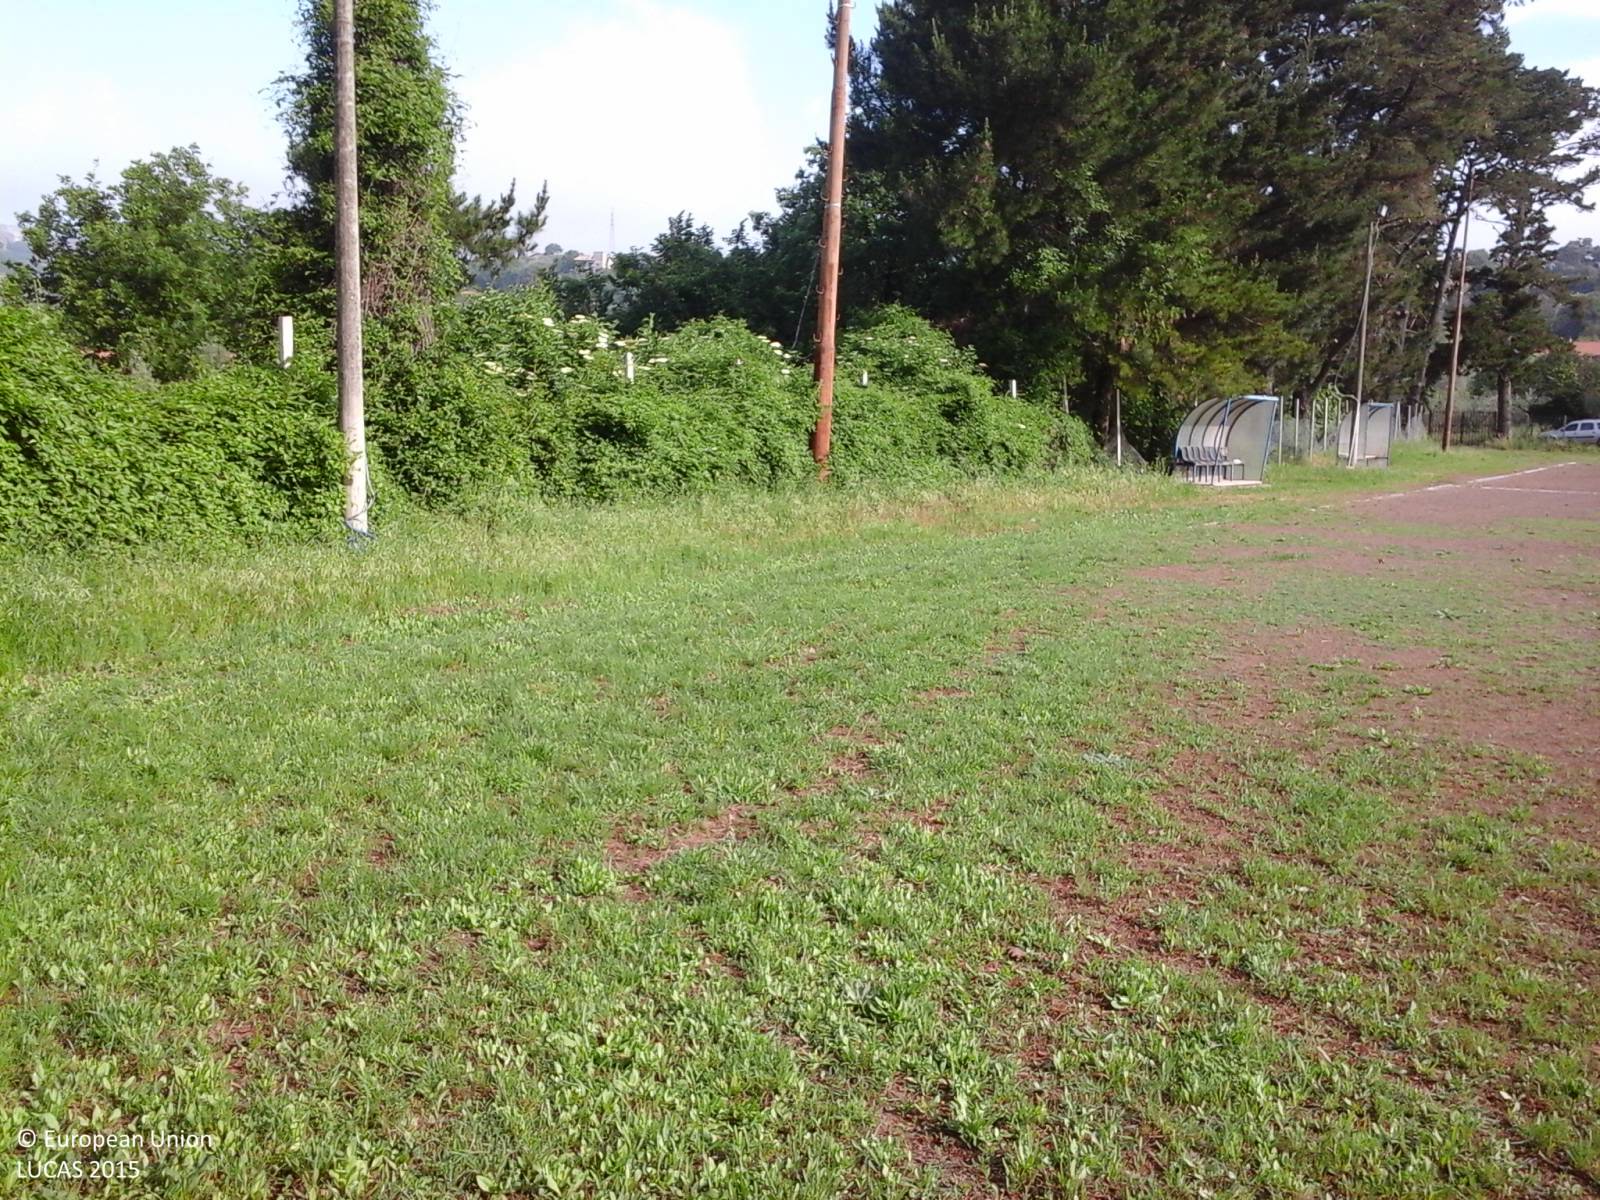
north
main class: Grassland
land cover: Grassland without tree/shrub cover
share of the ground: > 75 %
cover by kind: herbaceous plants 100 %
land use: Sport
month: May
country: IT
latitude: 42.5249
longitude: 12.0504
